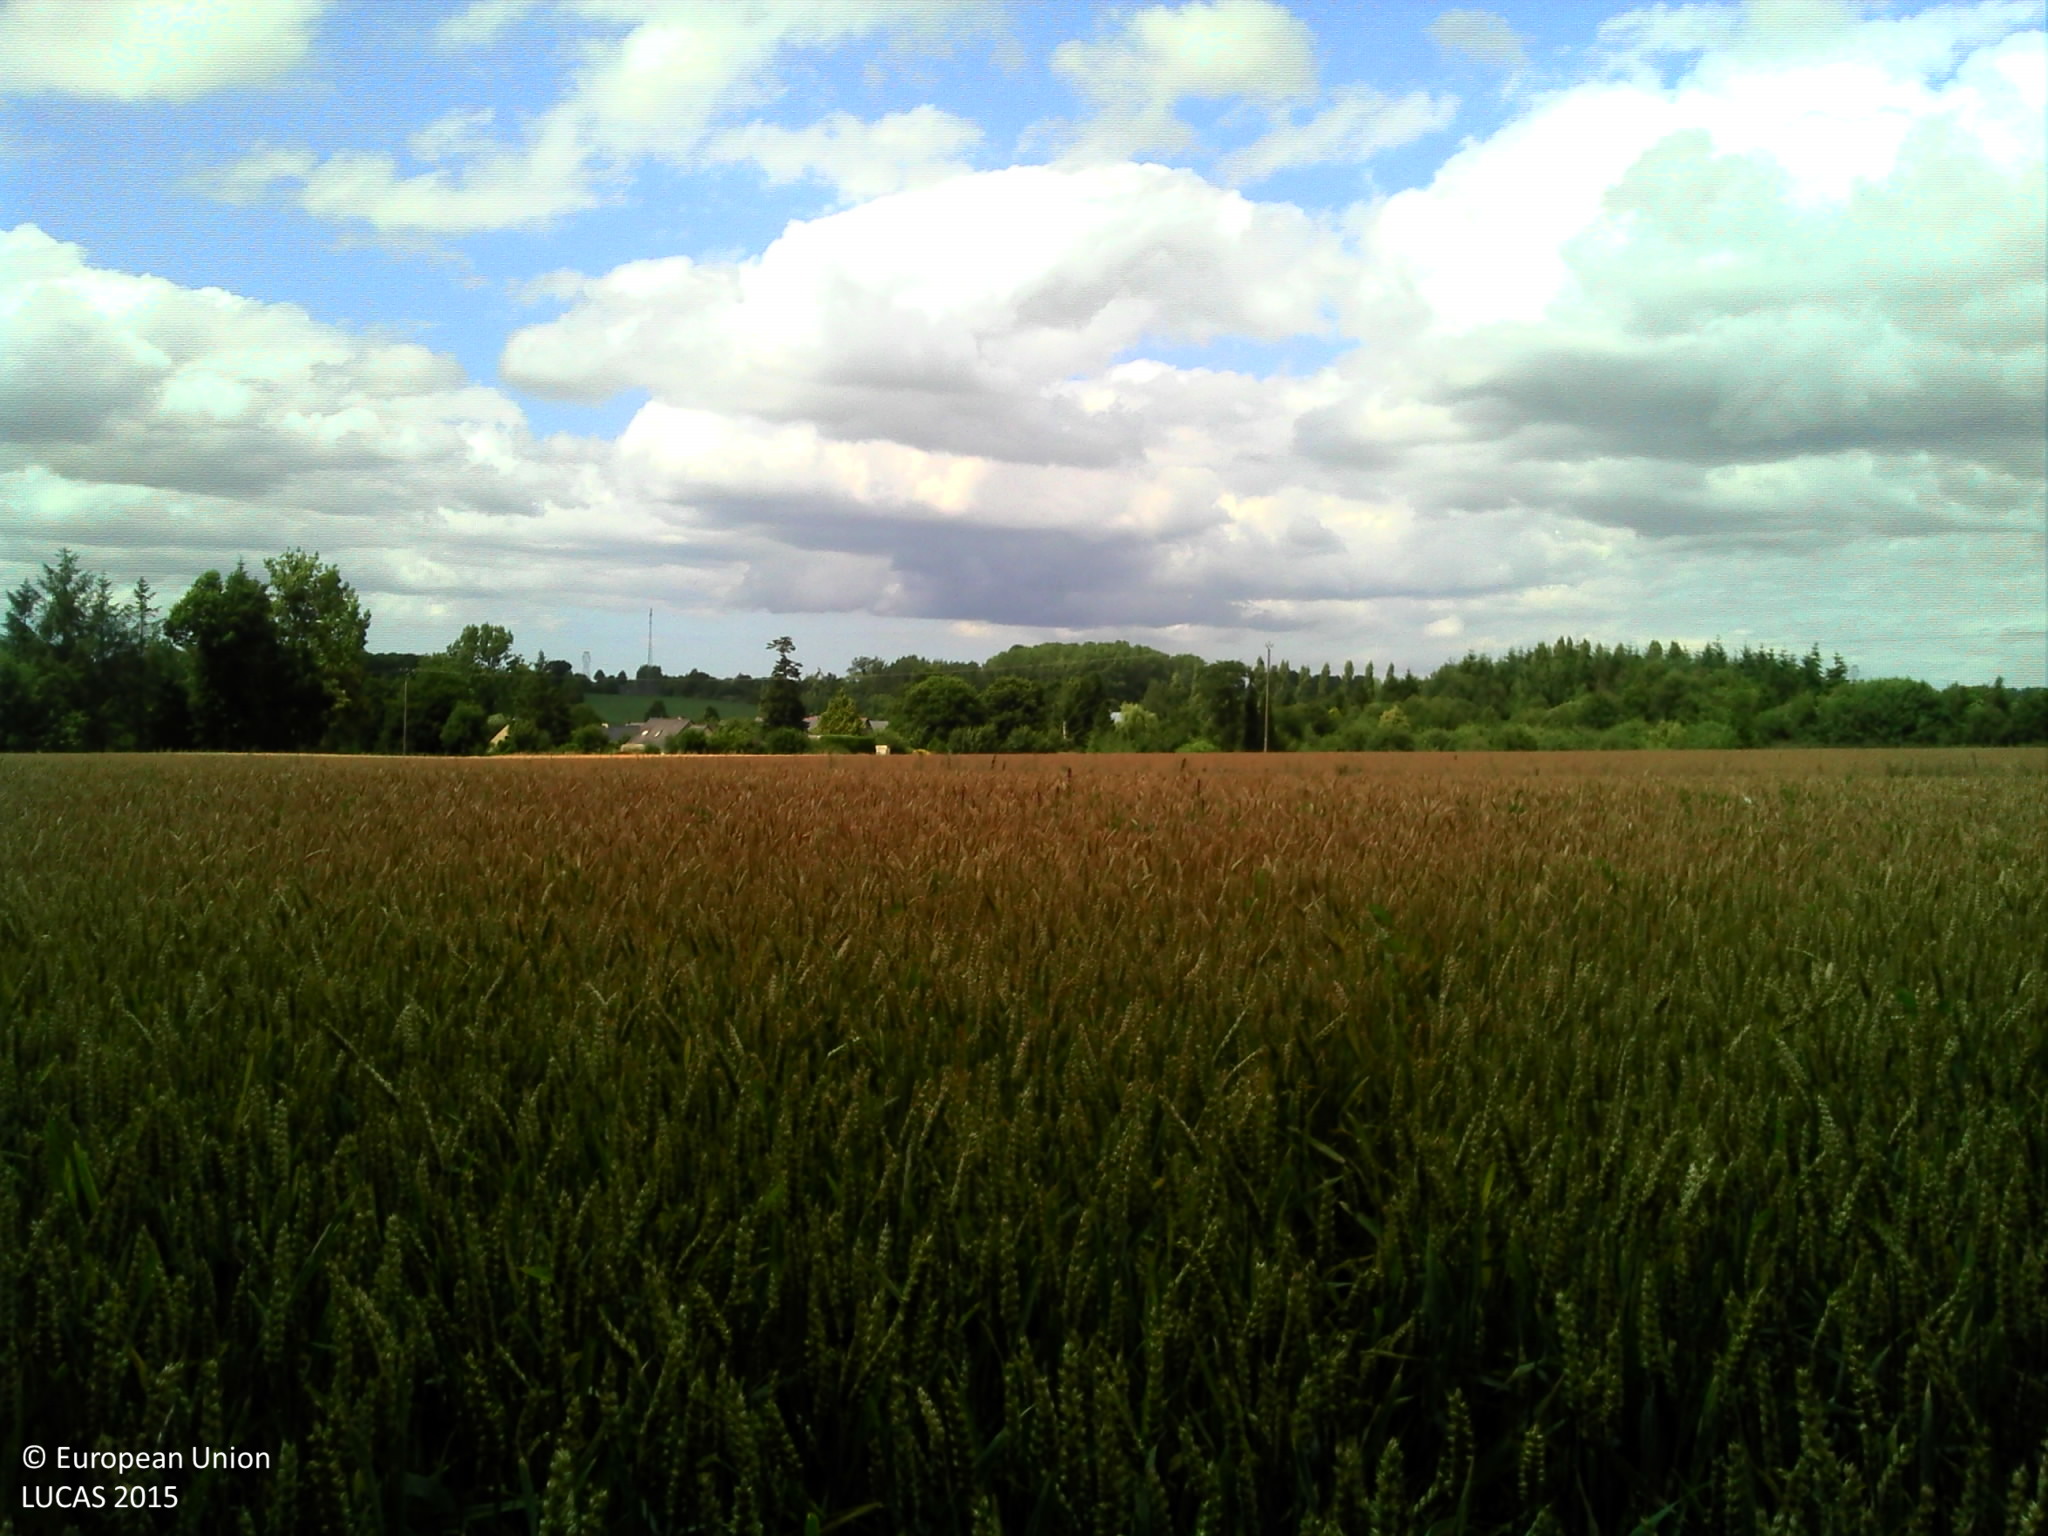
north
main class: Cropland
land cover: Common wheat
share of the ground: > 75 %
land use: Agriculture (excluding fallow land and kitchen gardens)
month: July
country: FR
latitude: 48.2418
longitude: -2.1336
